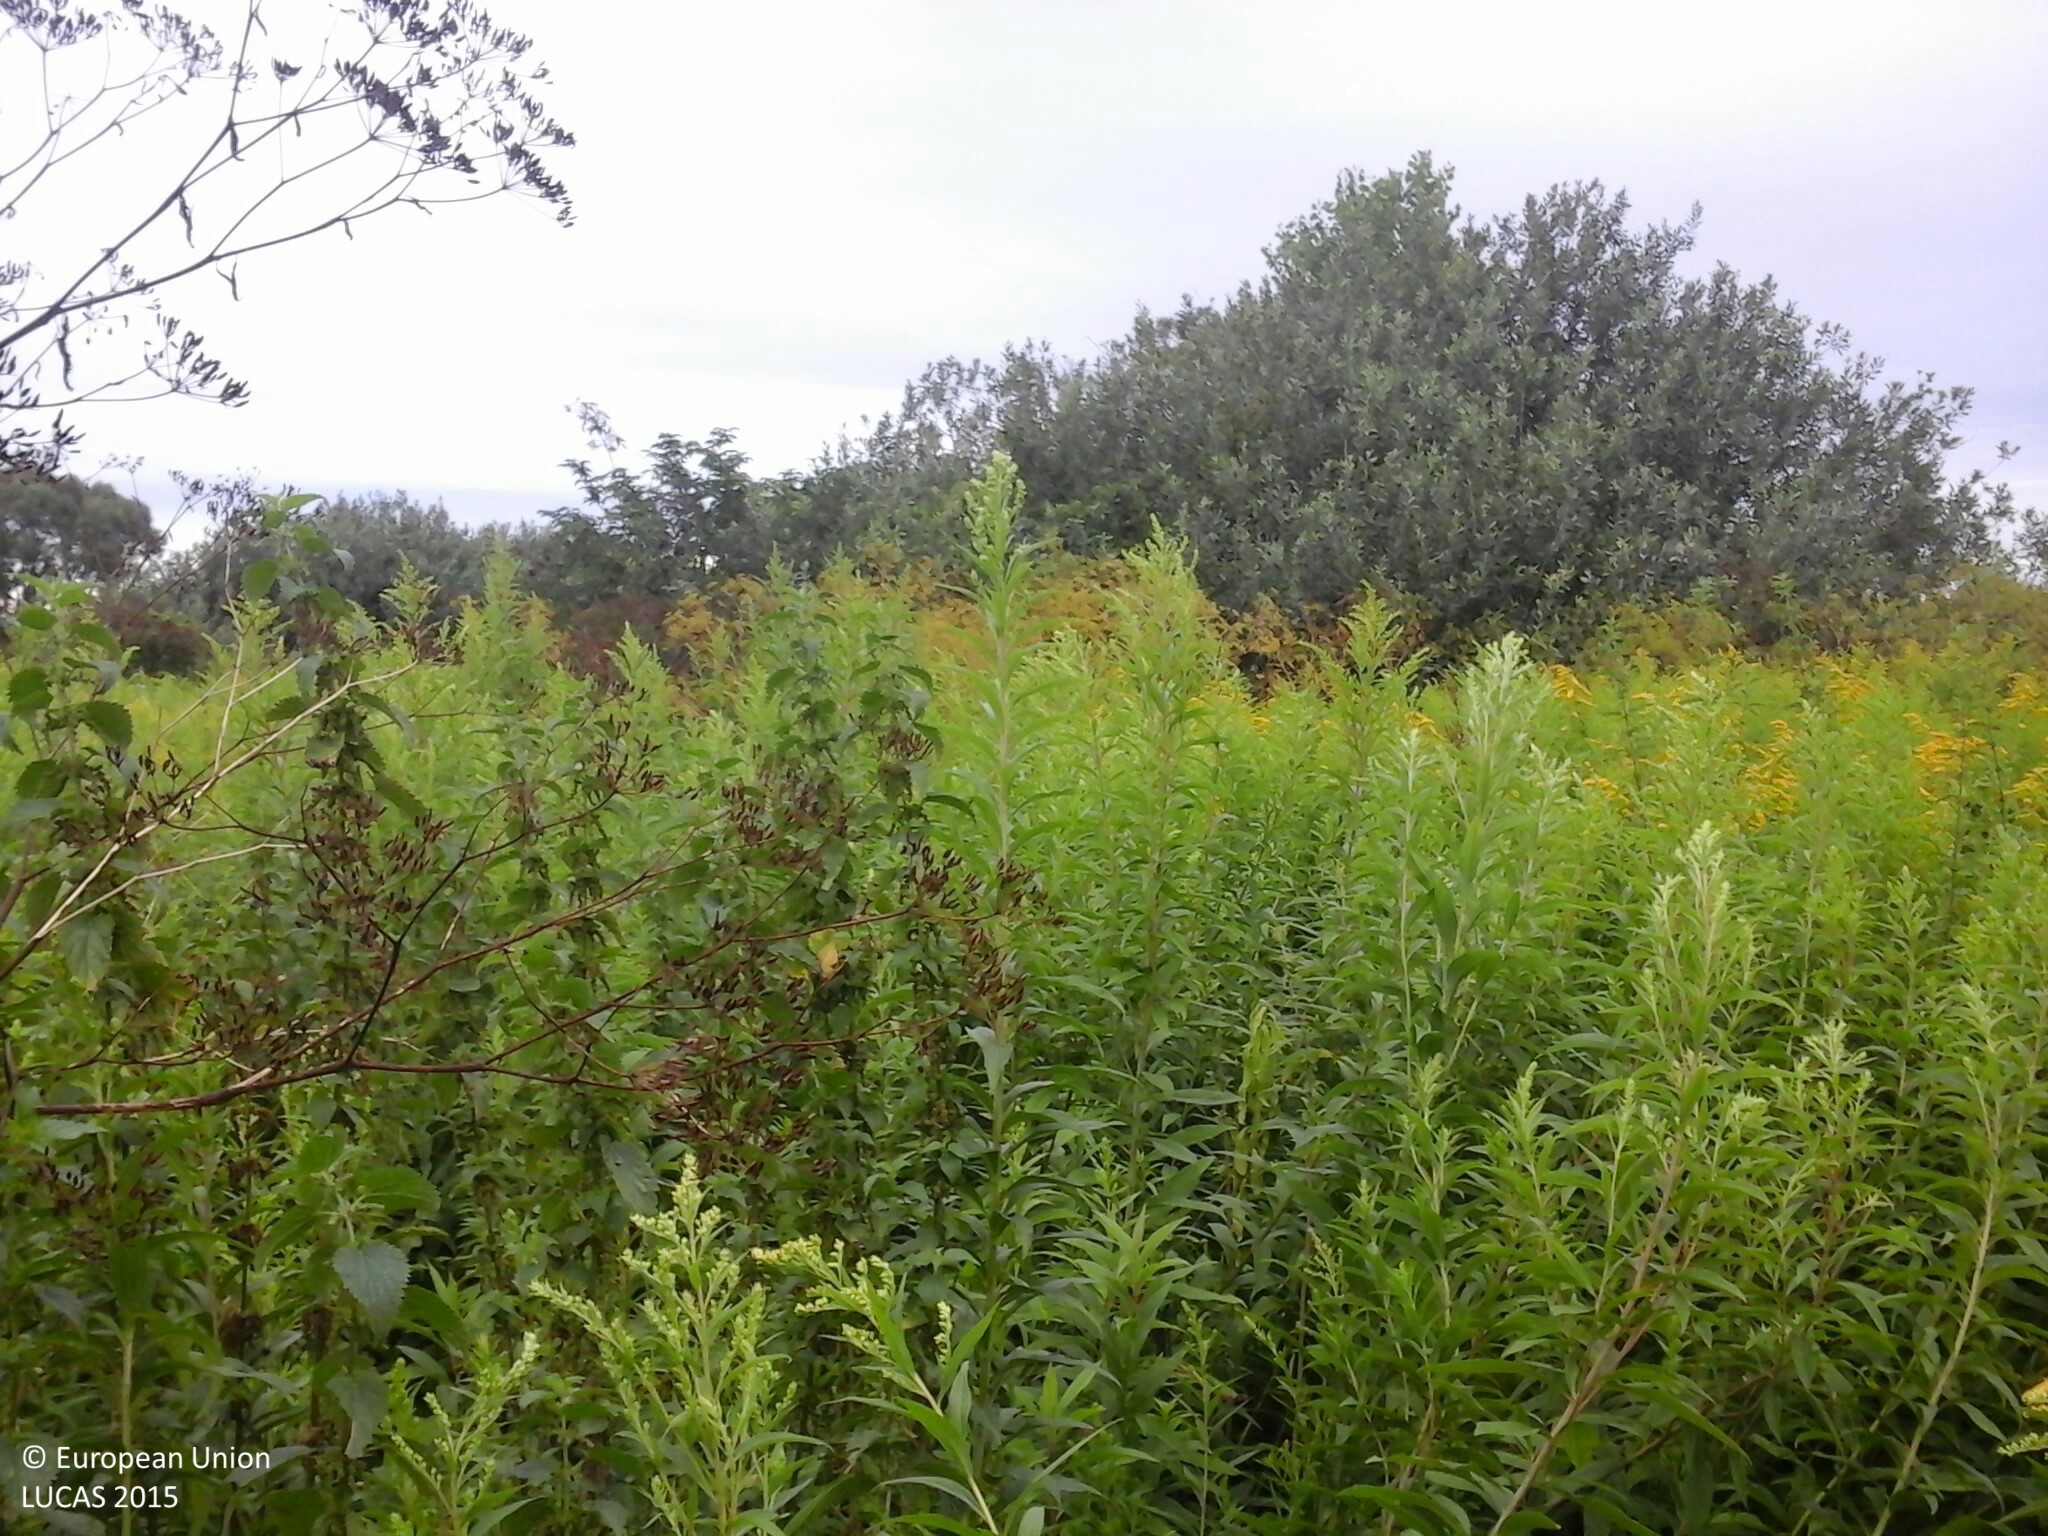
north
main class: Grassland
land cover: Spontaneously vegetated surfaces
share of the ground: > 75 %
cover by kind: herbaceous plants 100 %
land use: Semi-natural and natural areas not in use
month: July
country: HU
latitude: 46.5607
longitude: 17.7156
